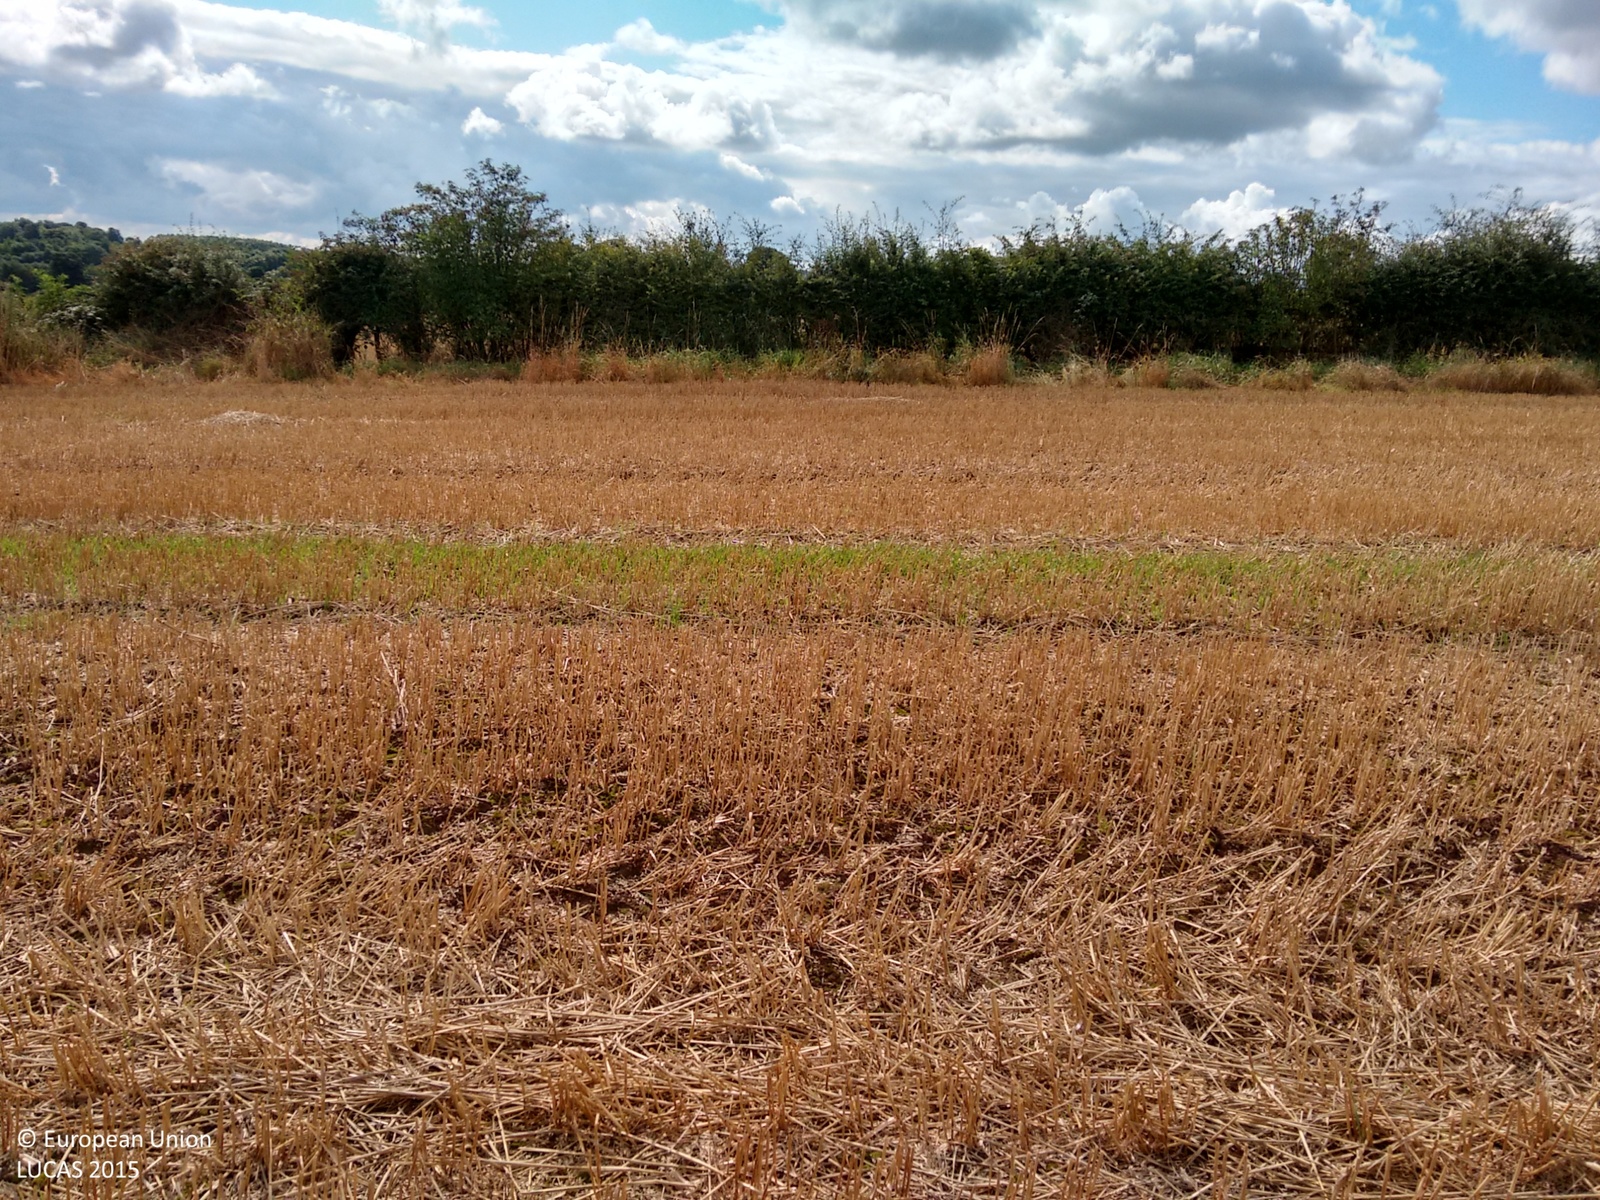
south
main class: Cropland
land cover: Common wheat
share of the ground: > 75 %
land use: Agriculture (excluding fallow land and kitchen gardens)
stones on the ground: < 10 %
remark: Harvested field
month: September
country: GB
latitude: 52.7867
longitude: -1.4224
